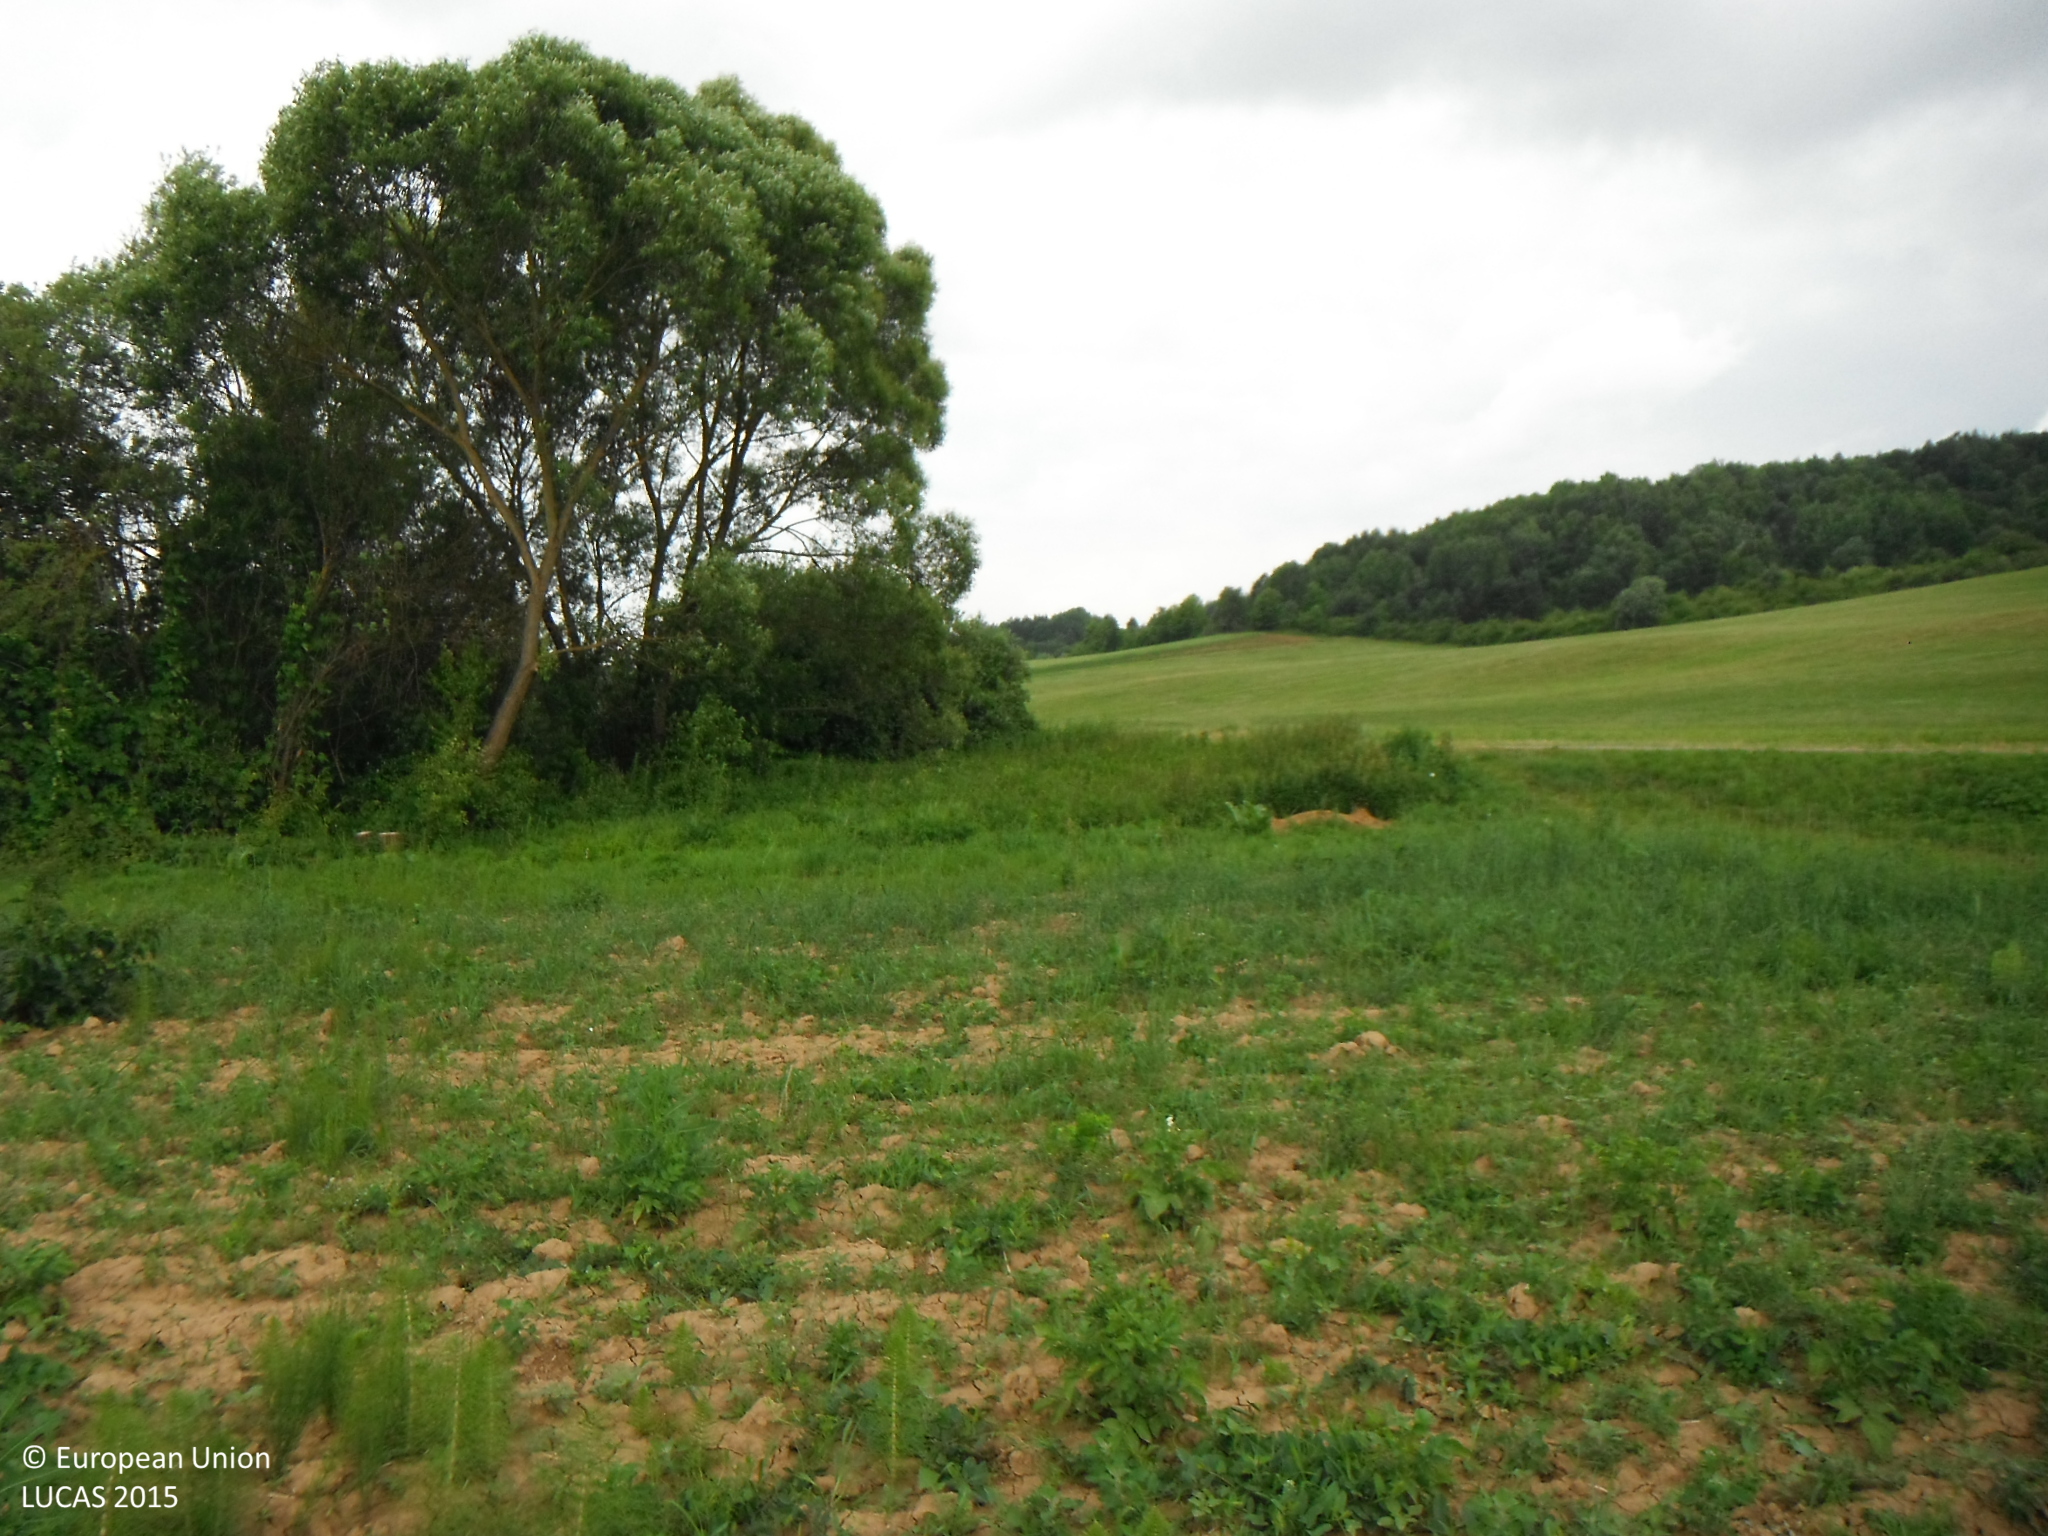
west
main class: Cropland
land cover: Potatoes
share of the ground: 25 - 50 %
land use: Kitchen garden
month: June
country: SK
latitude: 49.1398
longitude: 21.3831
